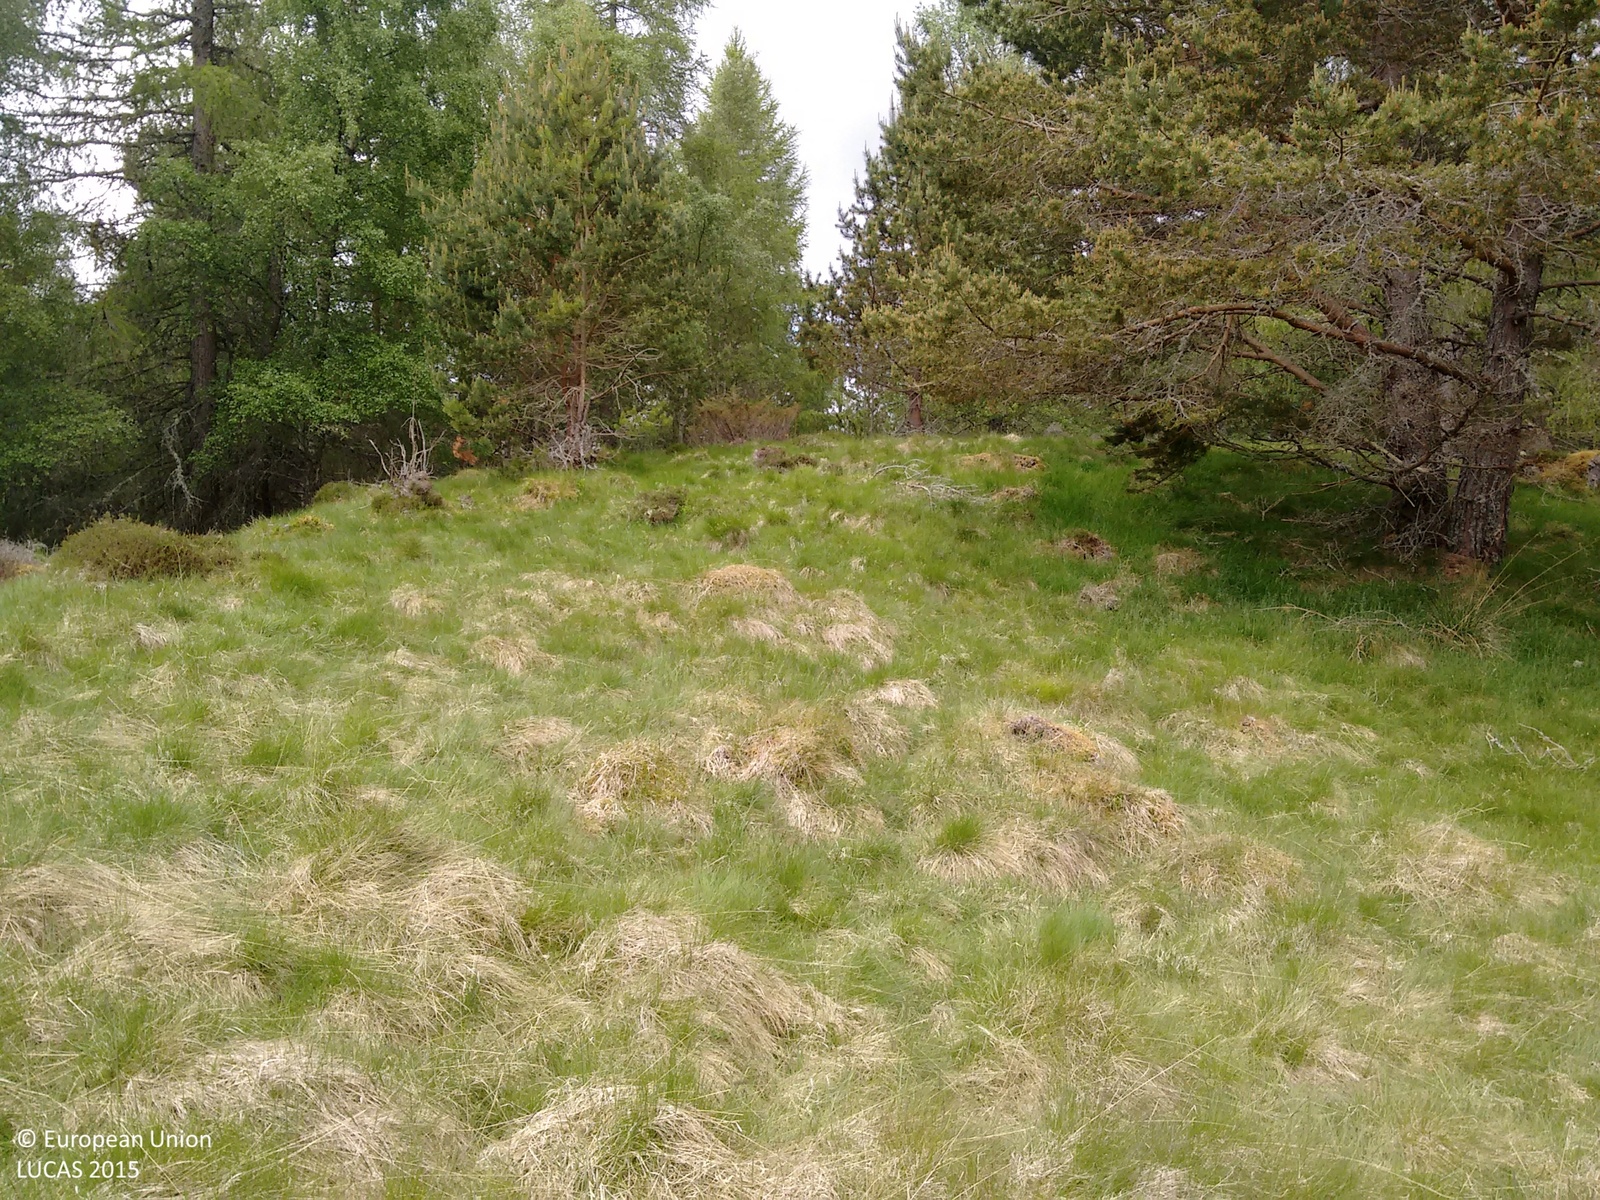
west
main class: Woodland
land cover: Pine dominated coniferous woodland
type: exotic forest
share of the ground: > 75 %
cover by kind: herbaceous plants 60 %, coniferous forest trees 30 %, shrubs 10 %
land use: Semi-natural and natural areas not in use
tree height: > 5 m
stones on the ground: < 10 %
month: June
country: GB
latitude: 57.0317
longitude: -3.2325
